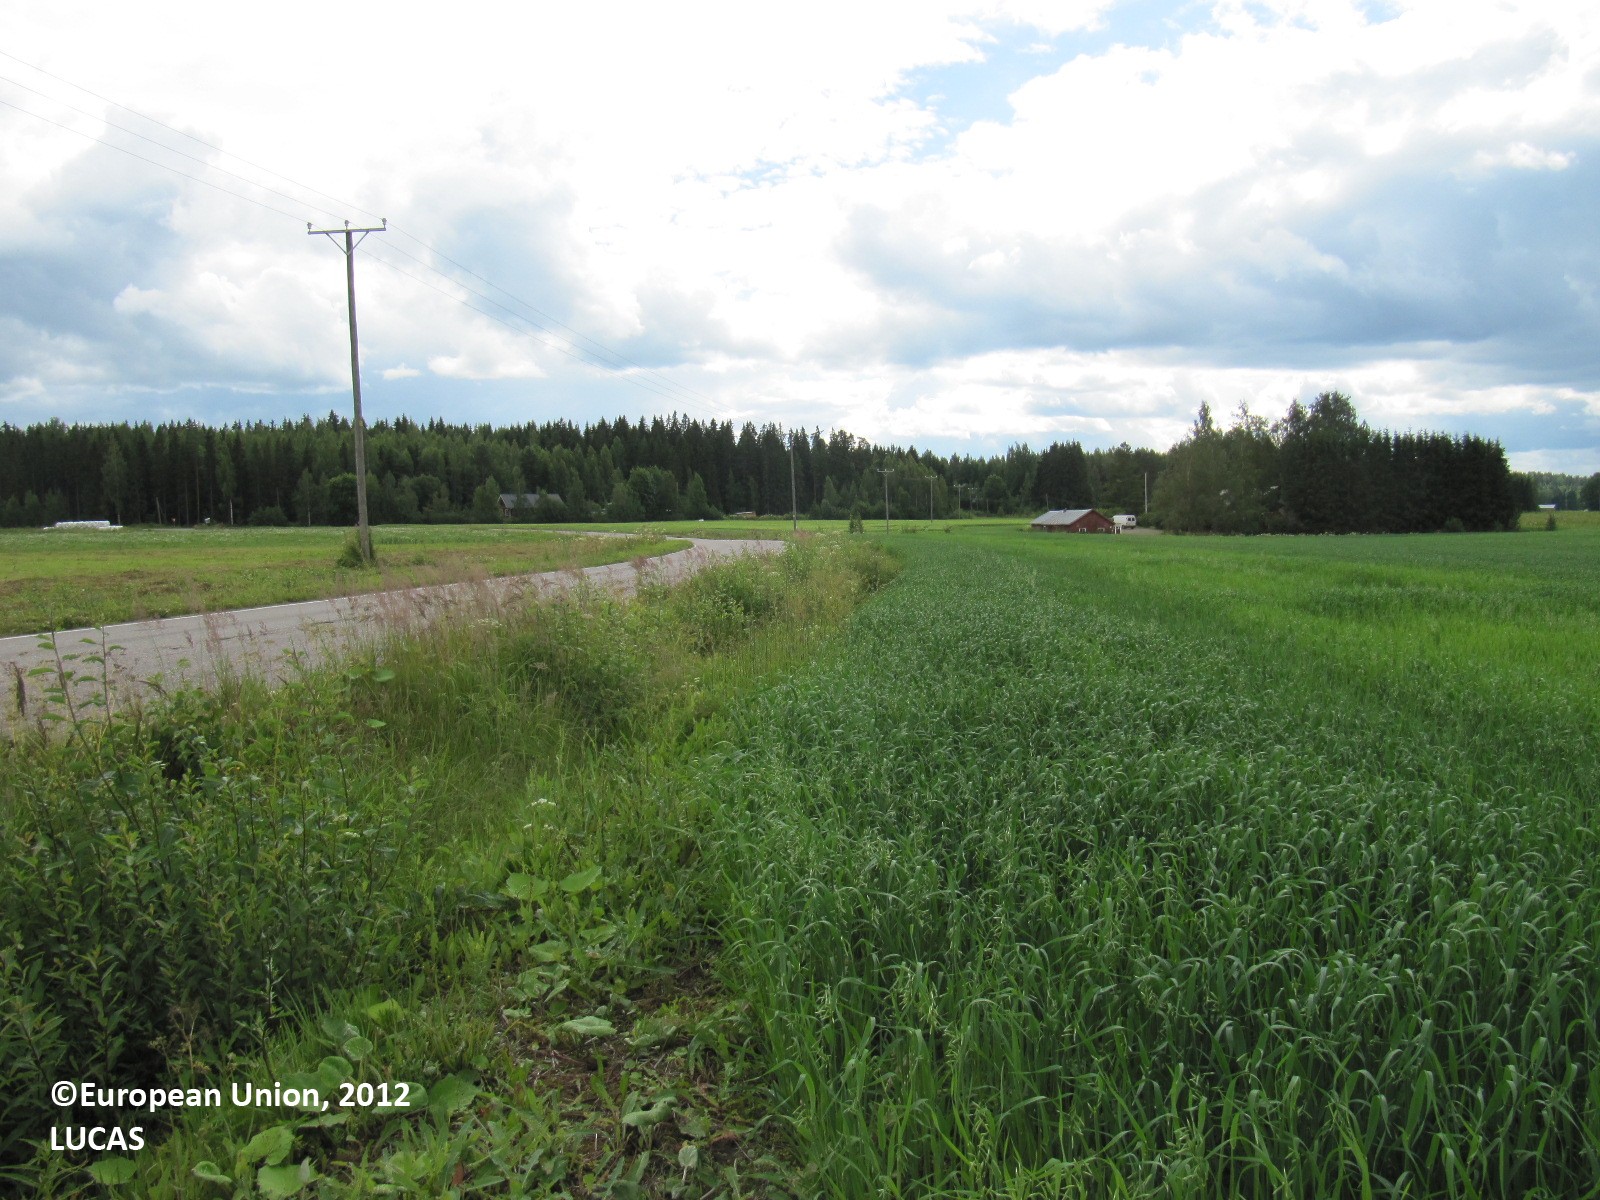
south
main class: Cropland
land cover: Oats
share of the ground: > 75 %
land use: Agriculture (excluding fallow land and kitchen gardens)
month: July
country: FI
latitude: 60.7847
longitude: 24.6727
